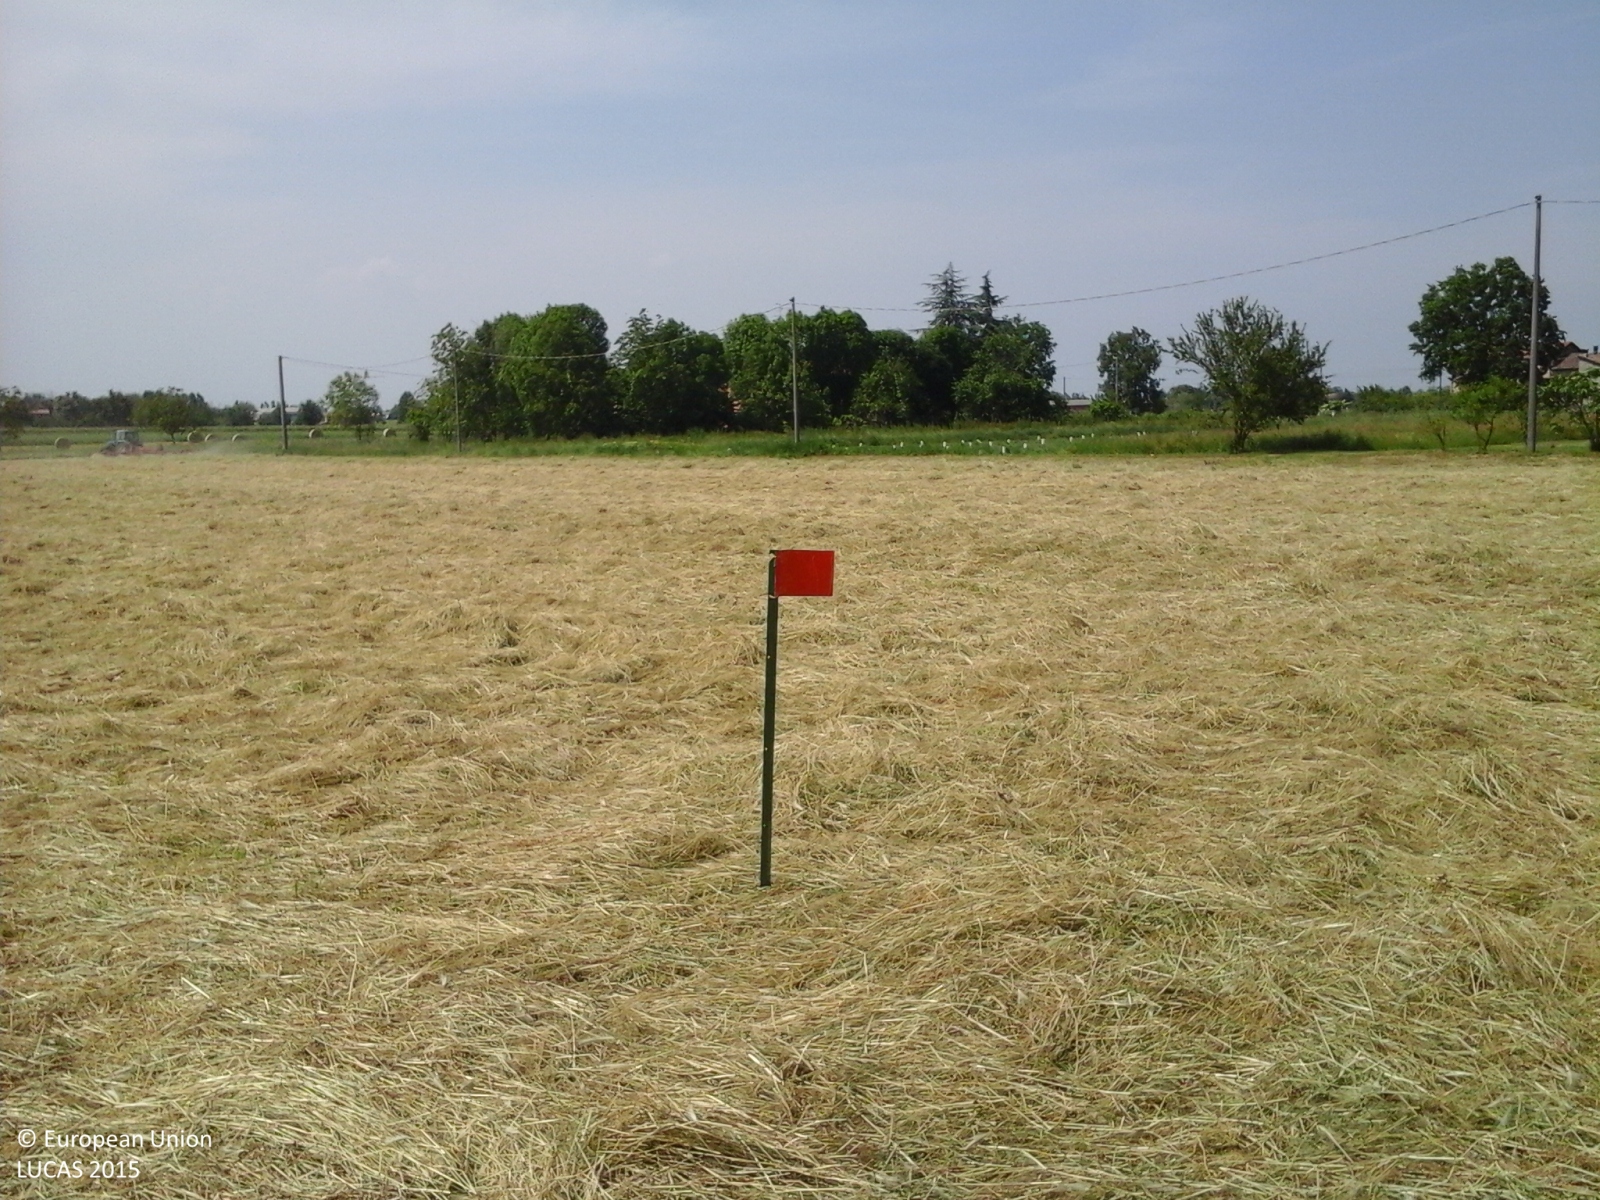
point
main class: Grassland
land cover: Spontaneously vegetated surfaces
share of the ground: > 75 %
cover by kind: herbaceous plants 100 %
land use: Agriculture (excluding fallow land and kitchen gardens)
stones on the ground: < 10 %
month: May
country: IT
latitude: 44.6004
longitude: 10.7417
